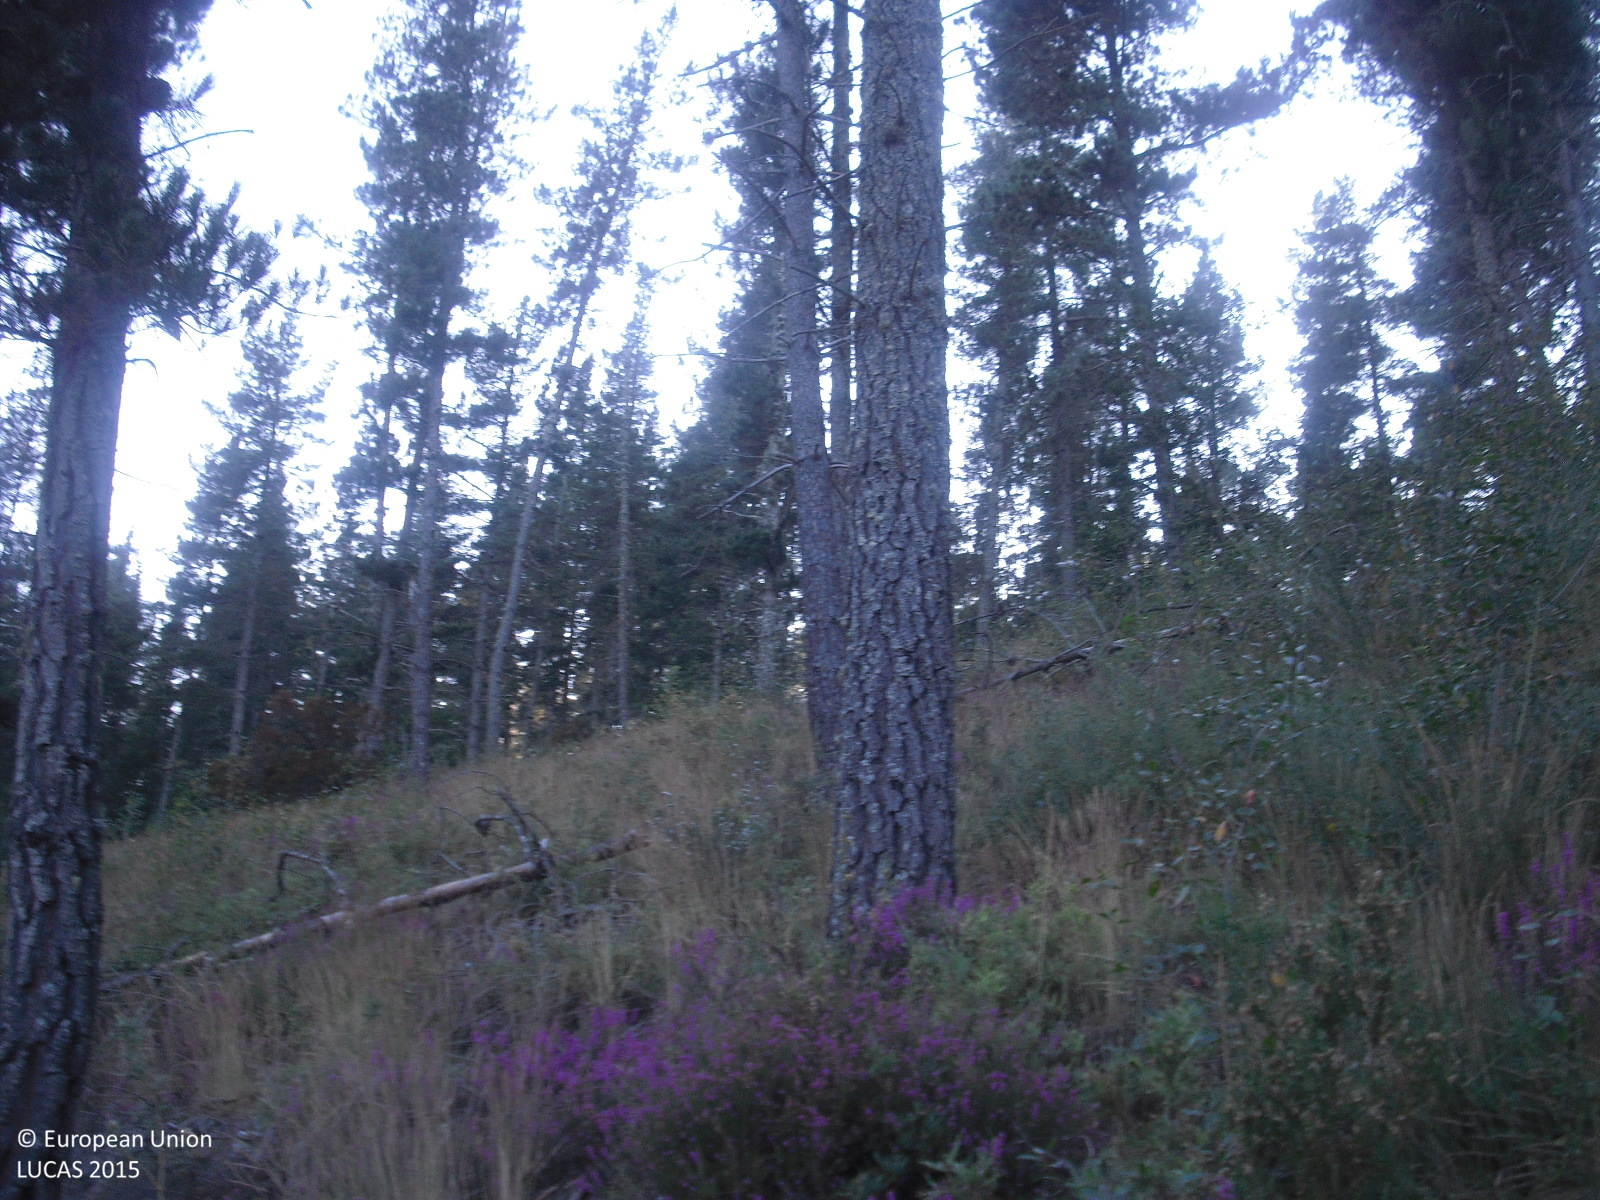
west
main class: Woodland
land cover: Pine dominated coniferous woodland
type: hemiboreal forest and nemoral coniferous forest and mixed broadleaved-coniferous forest
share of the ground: 25 - 50 %
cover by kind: shrubs 70 %, coniferous forest trees 30 %
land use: Forestry
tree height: > 5 m
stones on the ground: 25 - 50 %
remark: Clear cut
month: July
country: ES
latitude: 42.5703
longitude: -7.3025
